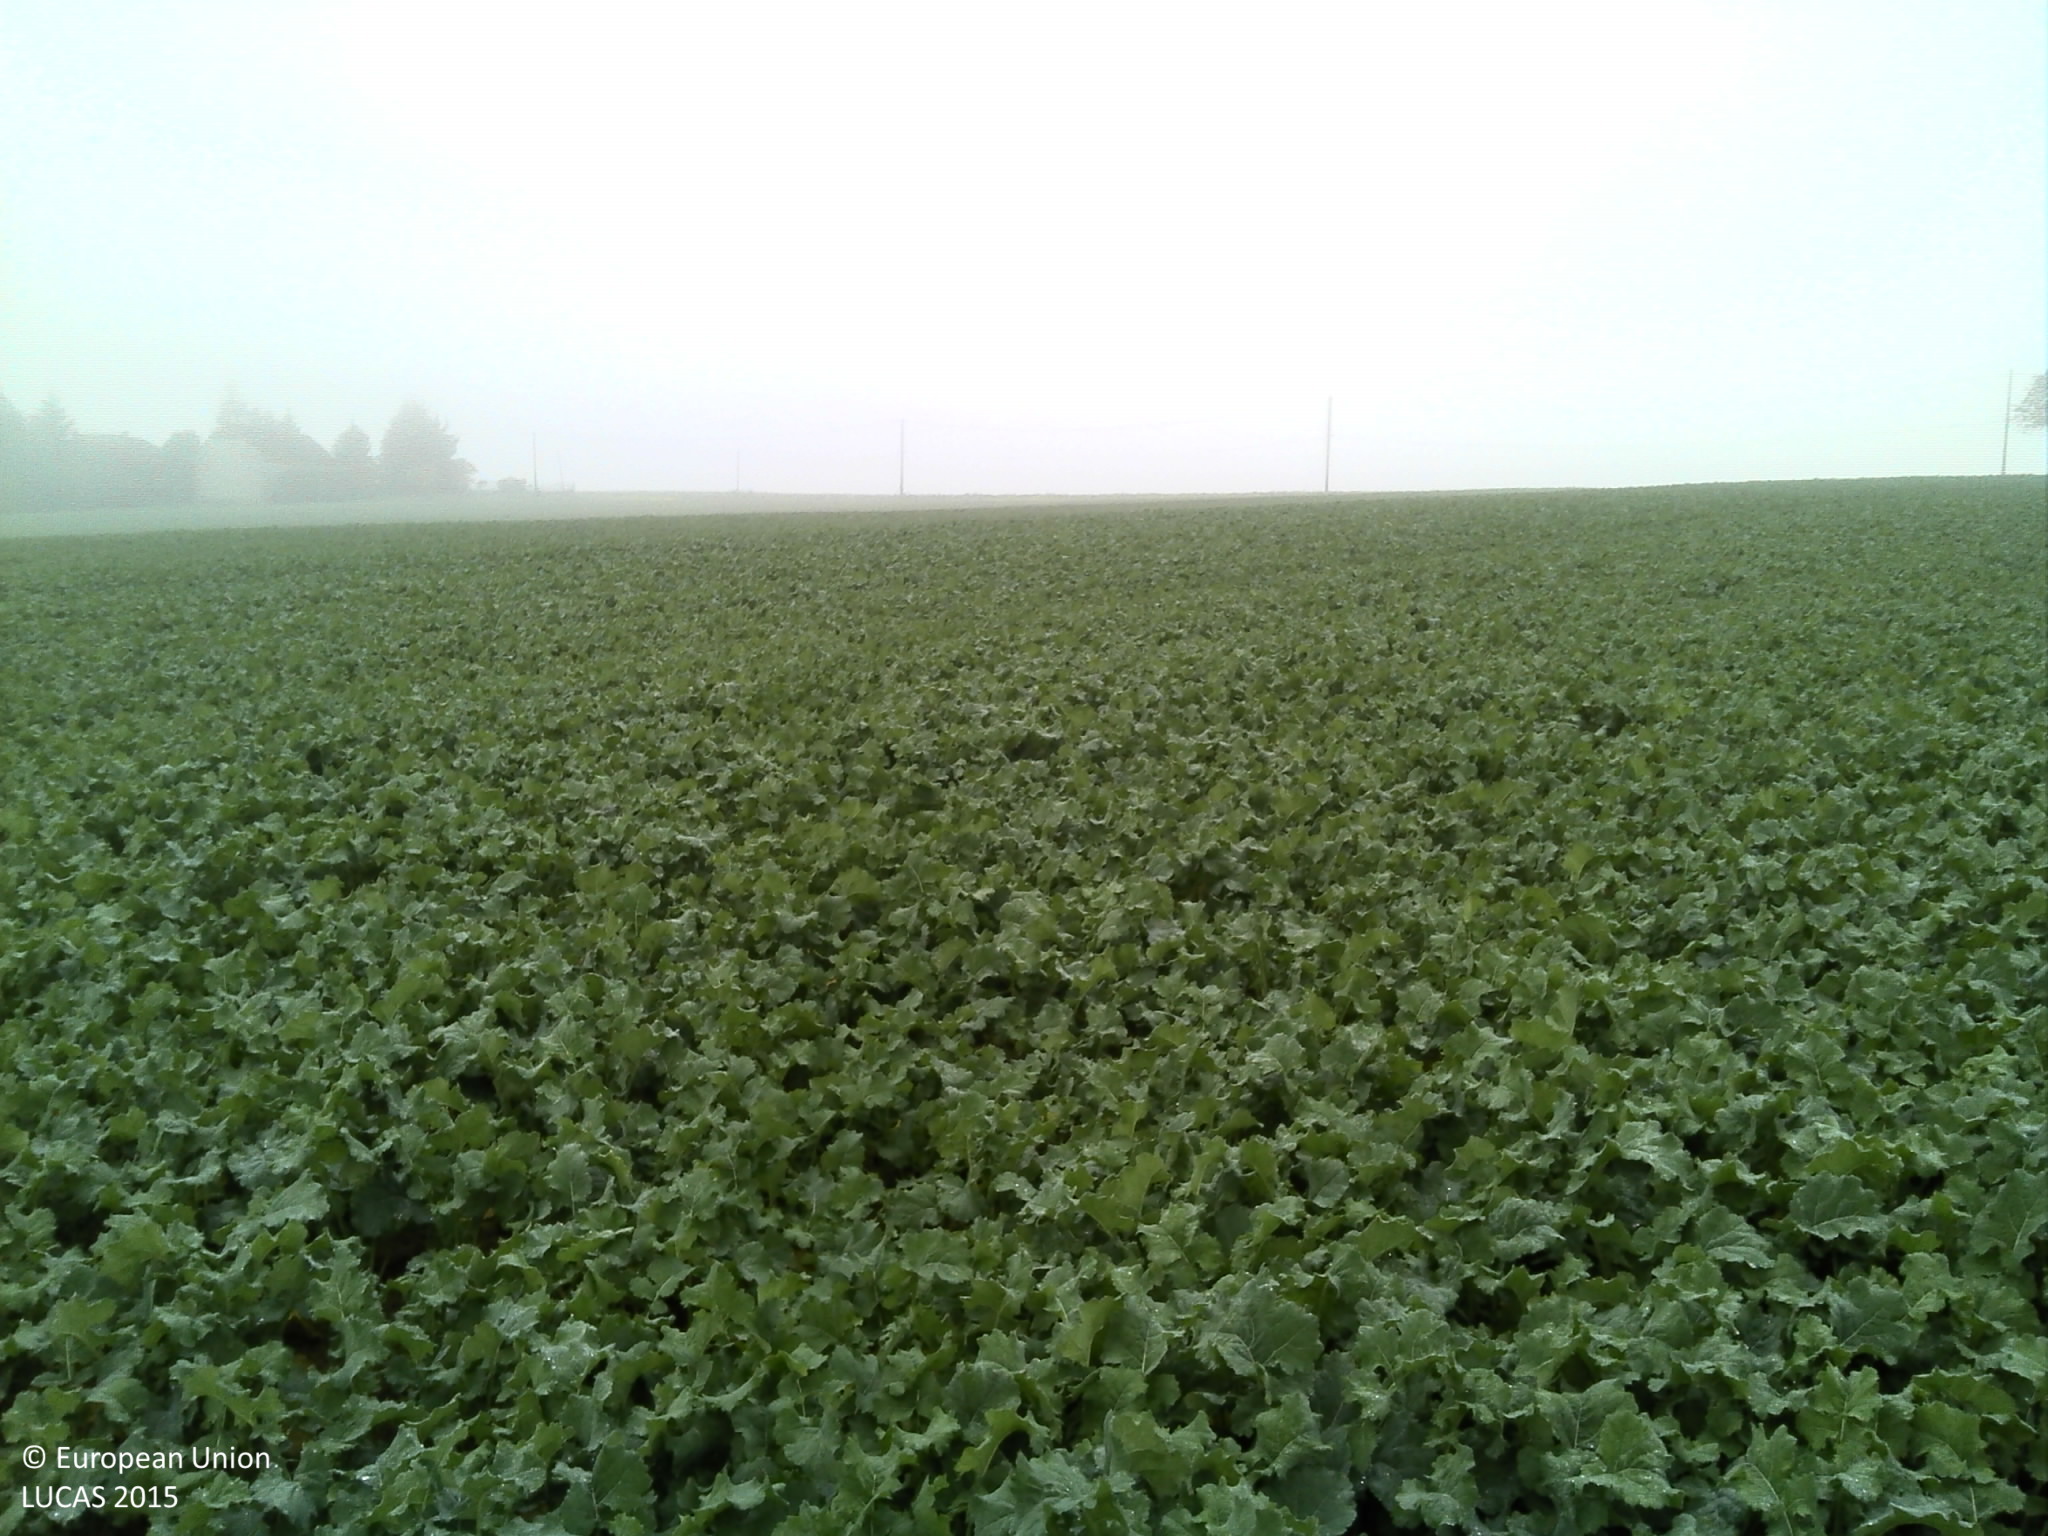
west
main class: Cropland
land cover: Rape and turnip rape
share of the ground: > 75 %
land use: Agriculture (excluding fallow land and kitchen gardens)
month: October
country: FR
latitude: 47.4369
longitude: 5.2670
